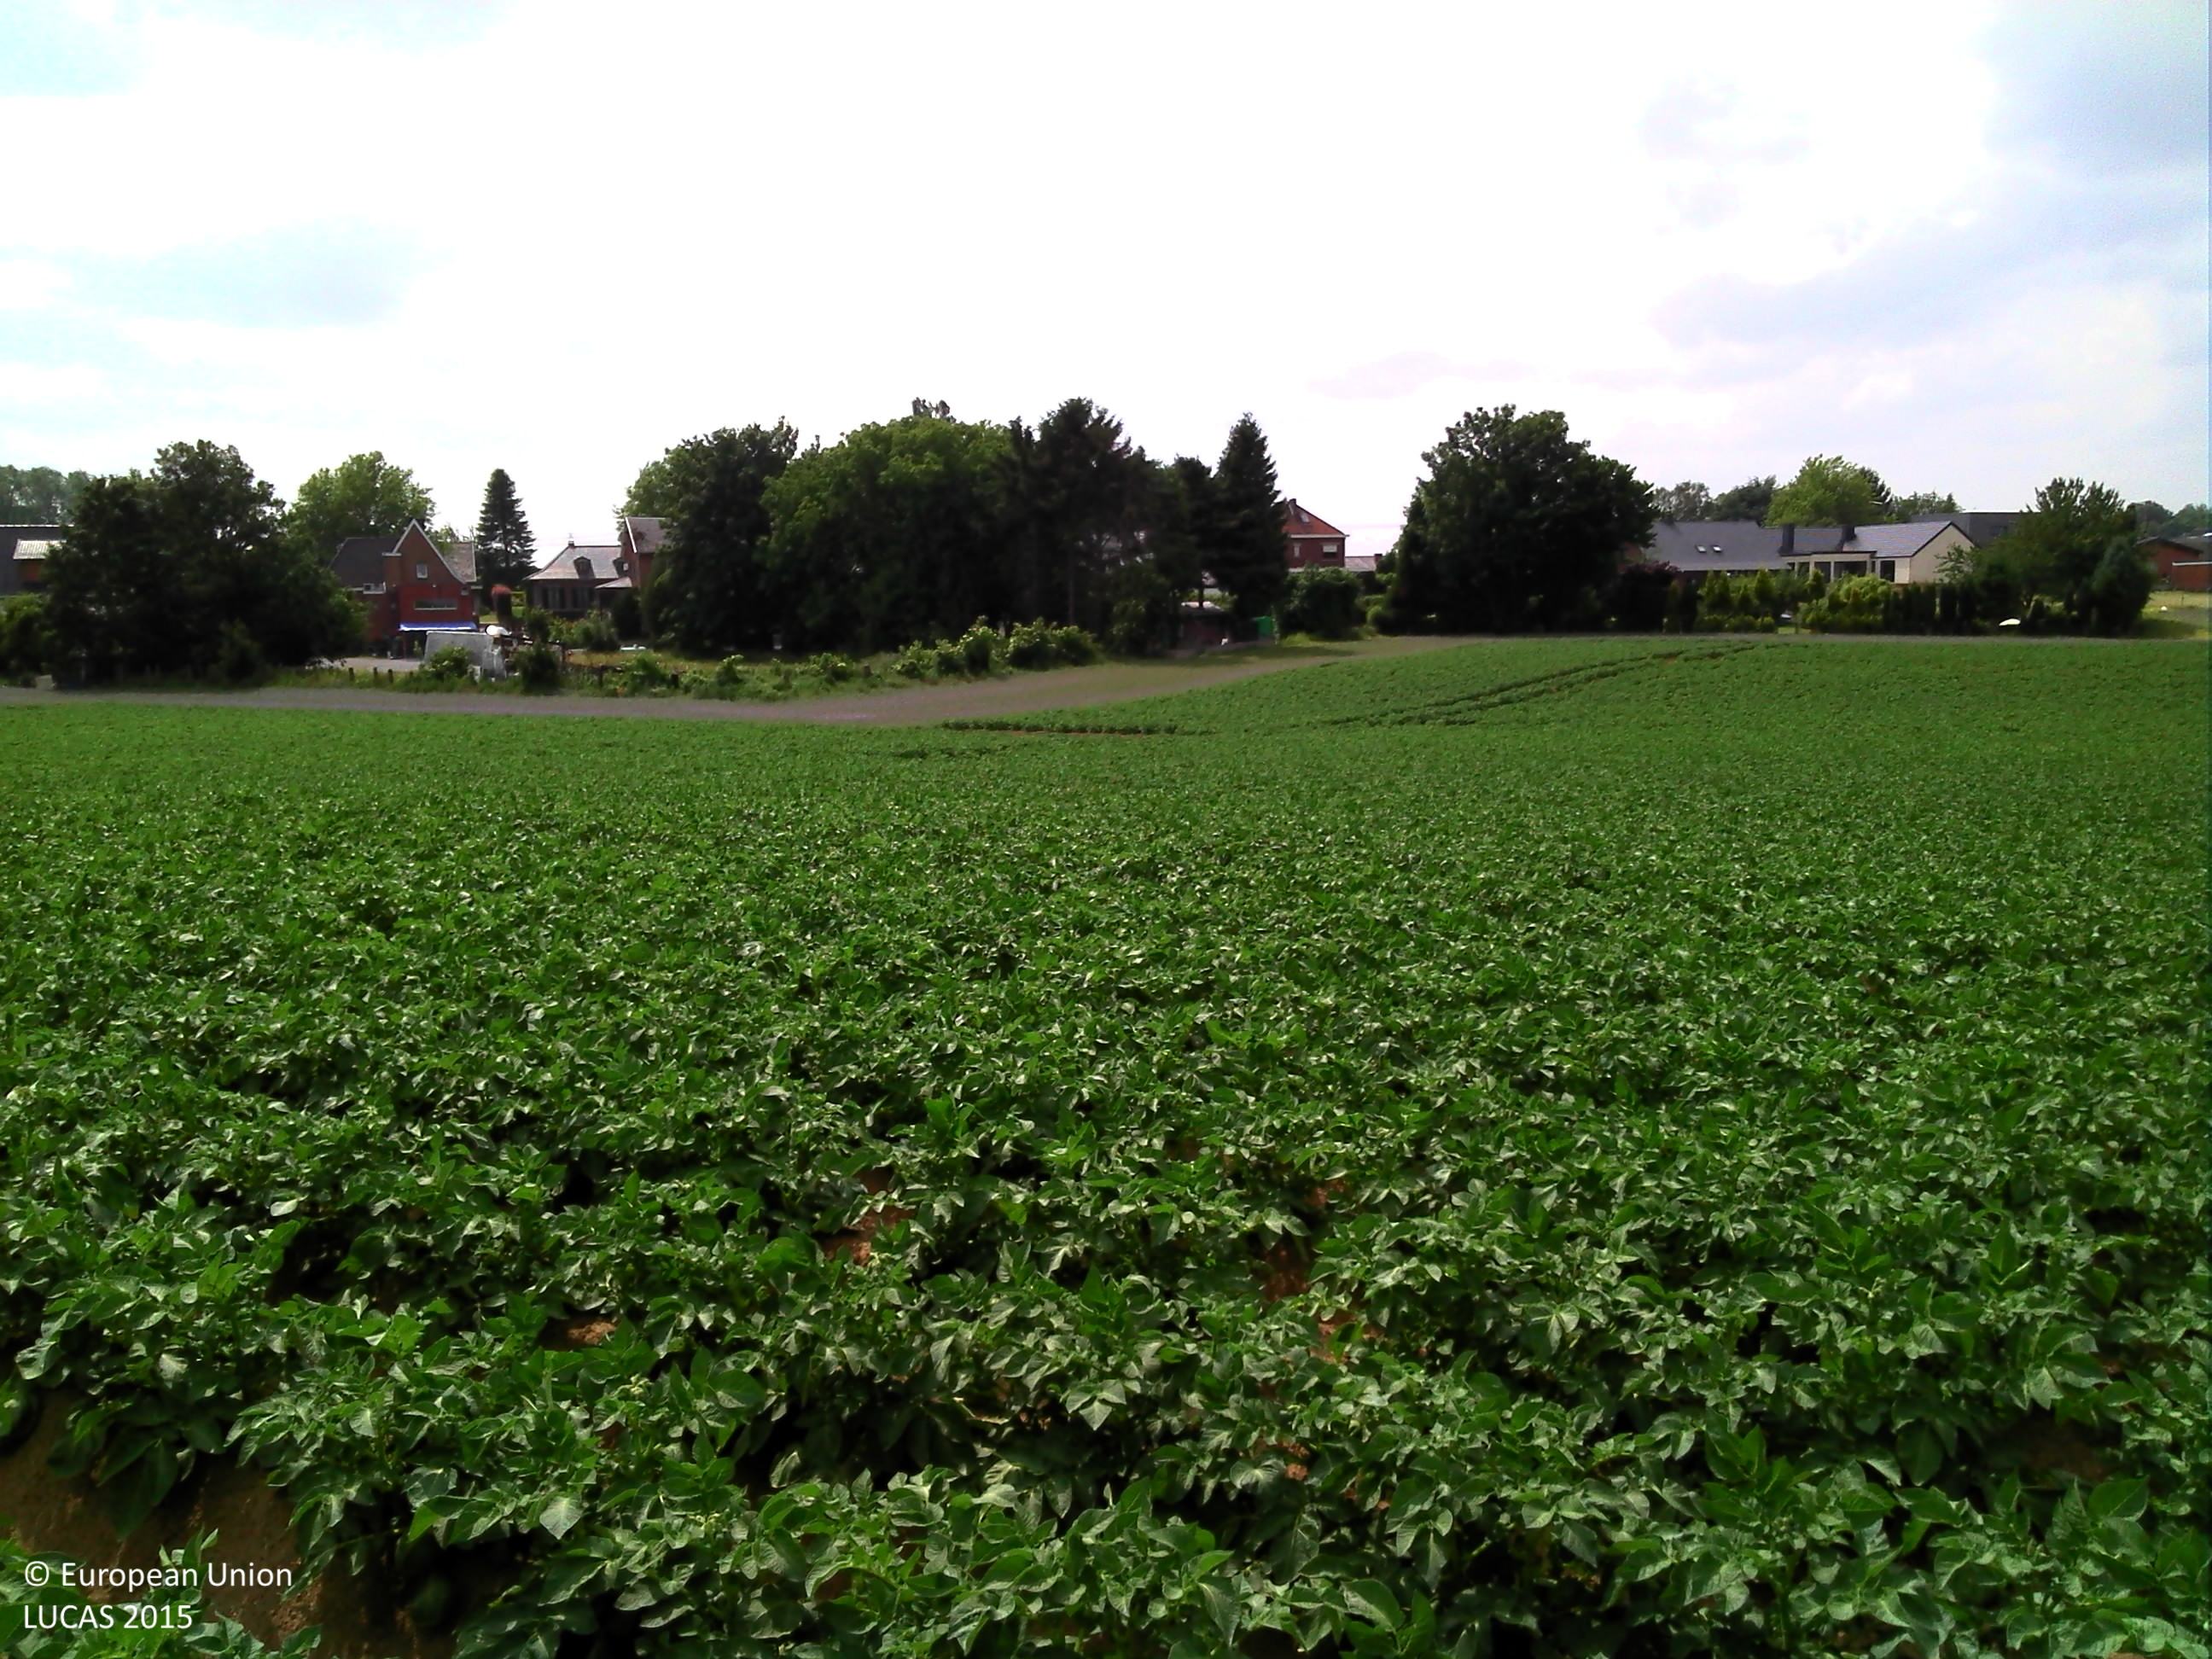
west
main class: Cropland
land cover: Potatoes
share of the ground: 50 - 75 %
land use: Agriculture (excluding fallow land and kitchen gardens)
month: June
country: BE
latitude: 50.6913
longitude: 5.5392
